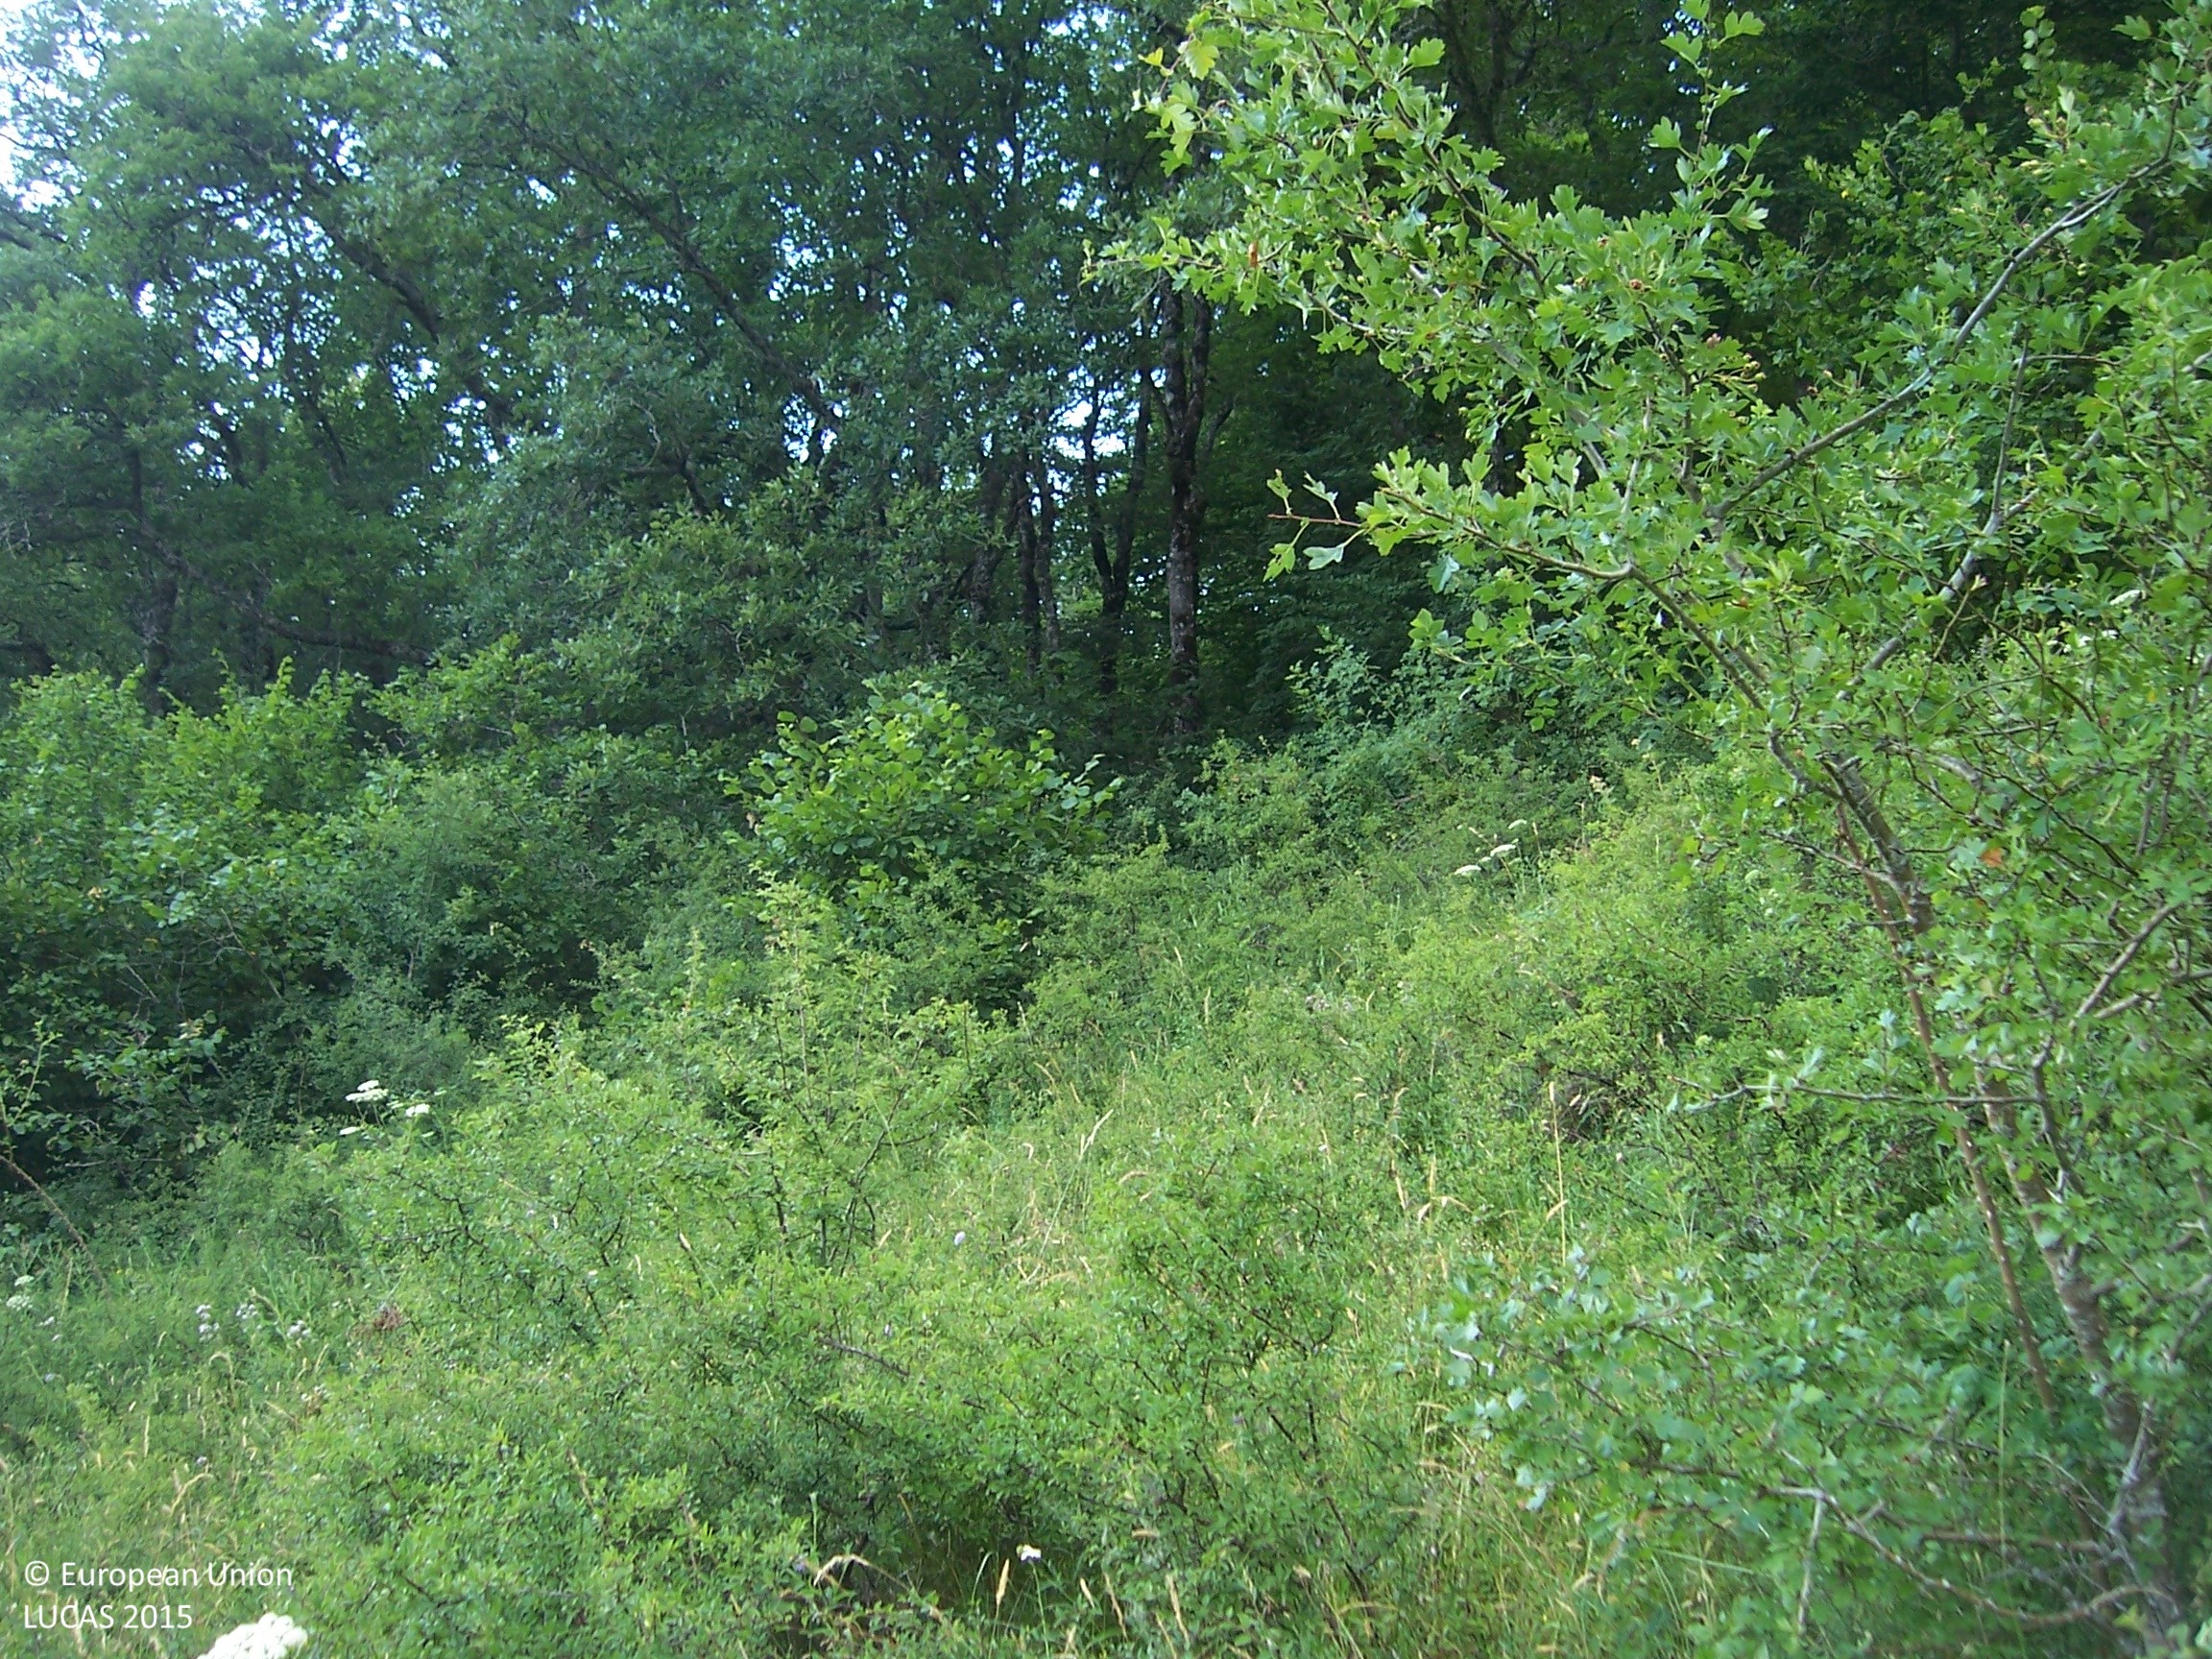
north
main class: Shrubland
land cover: Shrubland without tree cover
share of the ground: > 75 %
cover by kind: shrubs 60 %, herbaceous plants 40 %
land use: Agriculture (excluding fallow land and kitchen gardens)
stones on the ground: < 10 %
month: July
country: ES
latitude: 42.9868
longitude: -1.2831
